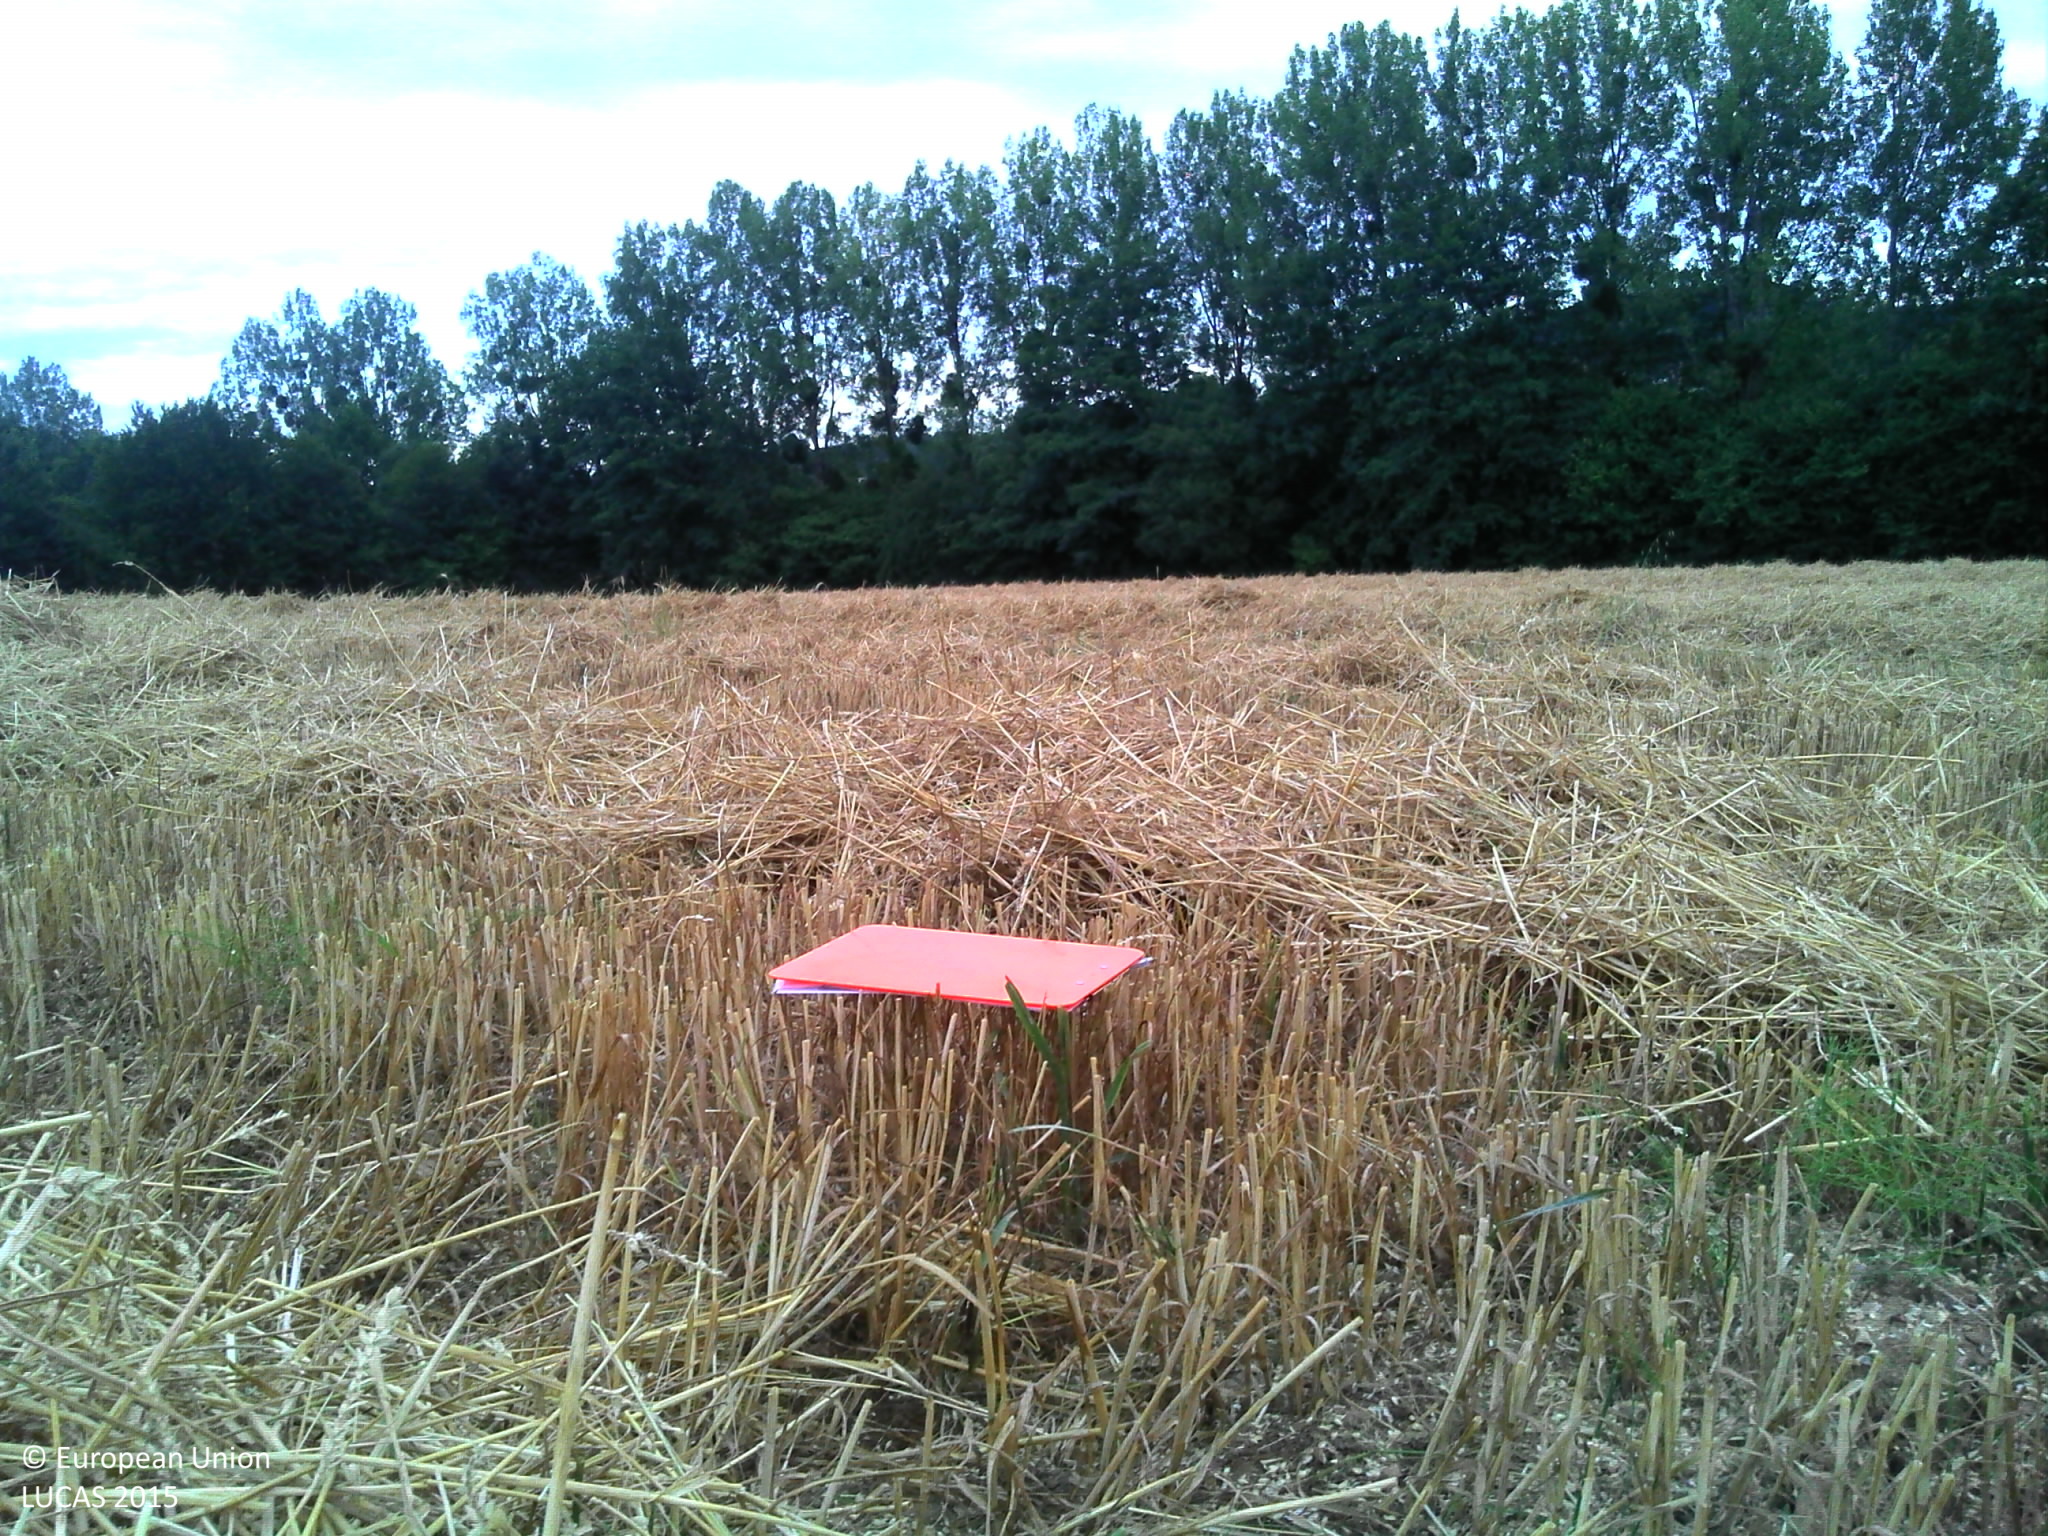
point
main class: Cropland
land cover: Common wheat
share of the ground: > 75 %
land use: Agriculture (excluding fallow land and kitchen gardens)
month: July
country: FR
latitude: 48.6470
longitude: 0.5145
